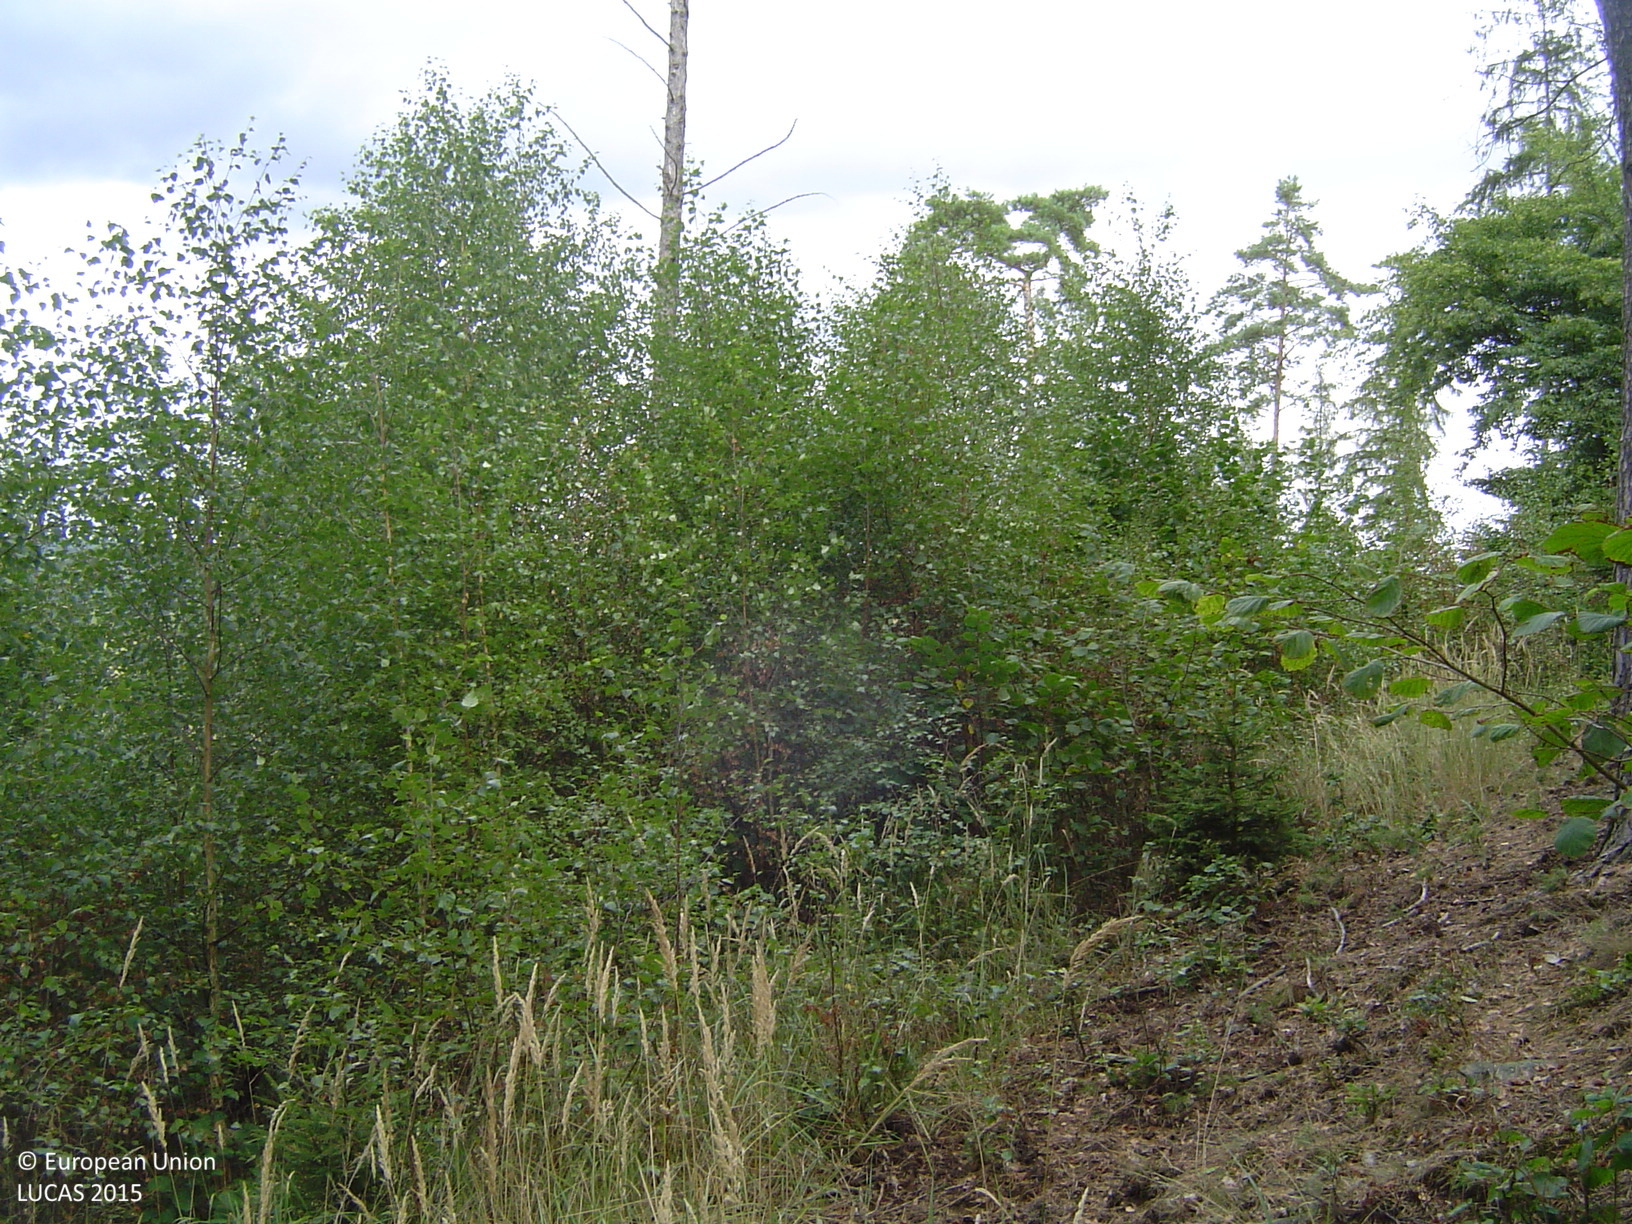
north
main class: Woodland
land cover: Pine dominated mixed woodland
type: hemiboreal forest and nemoral coniferous forest and mixed broadleaved-coniferous forest
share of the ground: > 75 %
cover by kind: coniferous forest trees 65 %, broadleaved forest trees 25 %, shrubs 10 %
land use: Forestry
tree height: > 5 m
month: August
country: CZ
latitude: 49.7930
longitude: 14.4050
